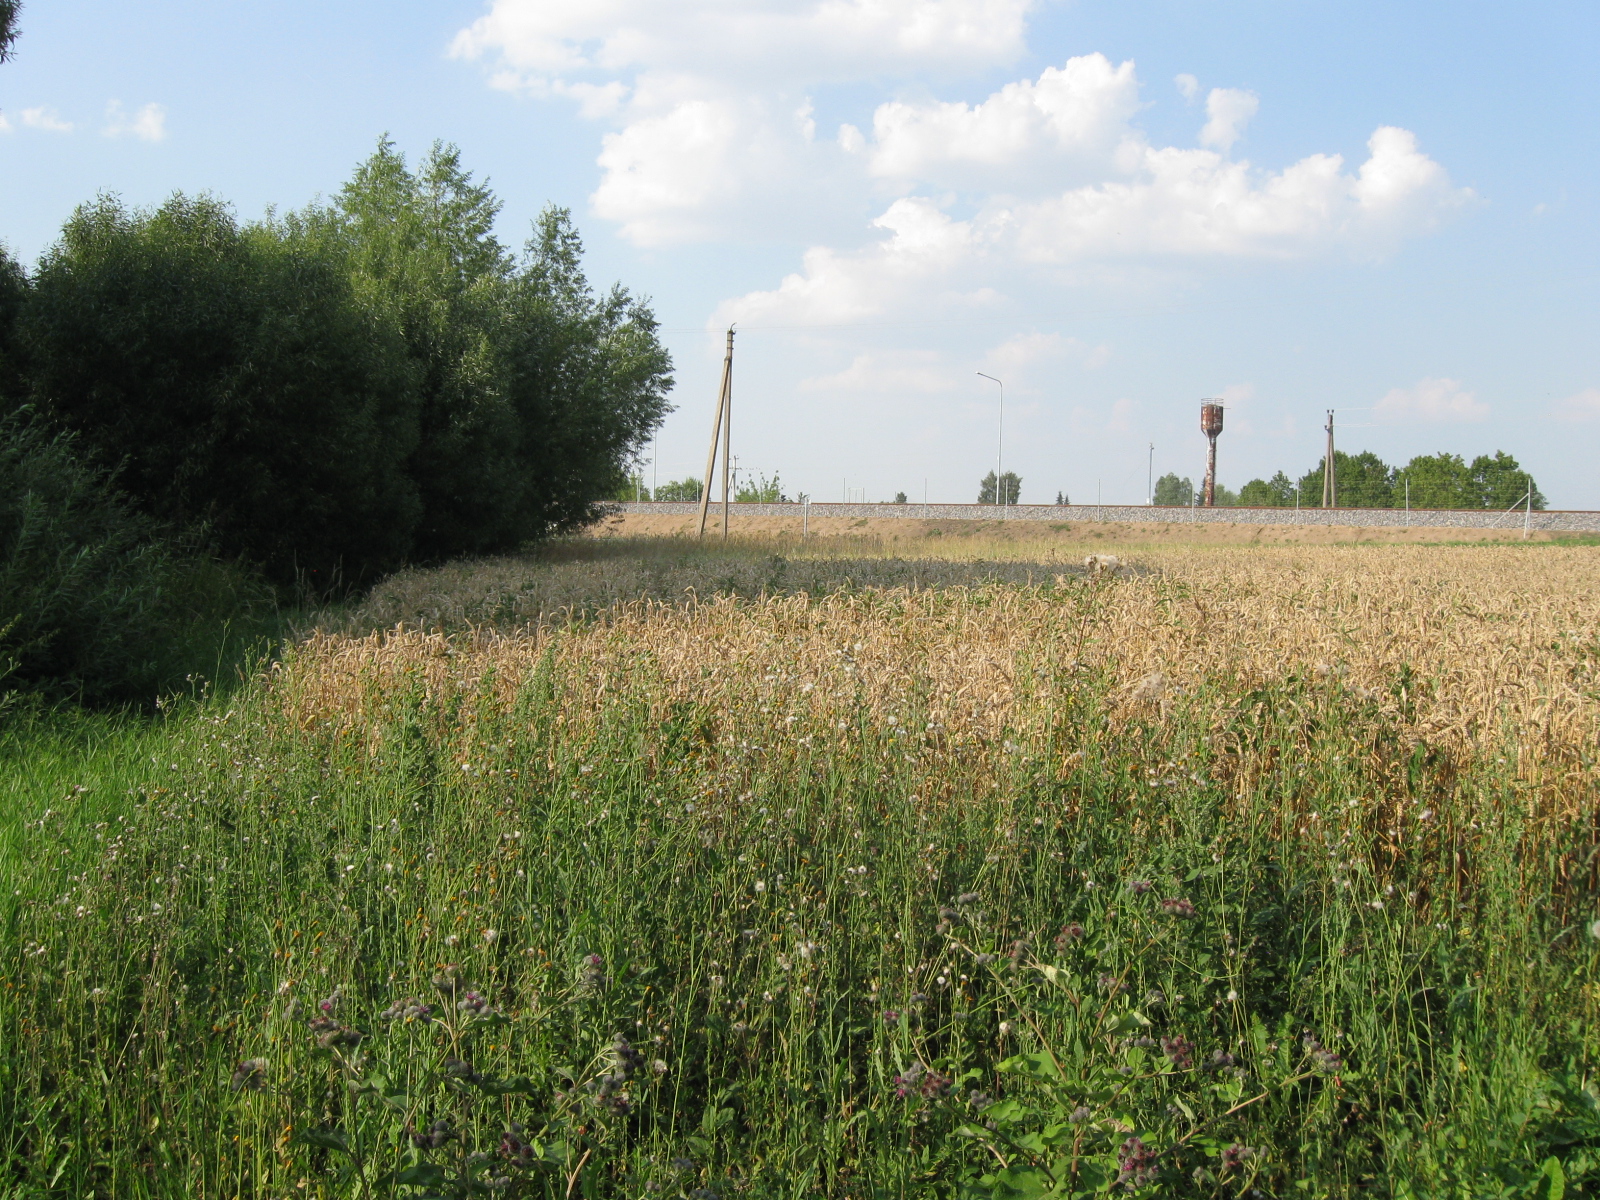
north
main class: Cropland
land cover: Apple fruit
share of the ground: 10 - 25 %
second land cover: Grassland without tree/shrub cover
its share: > 75 %
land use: Kitchen garden
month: August
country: LT
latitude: 54.4374
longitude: 23.2597
